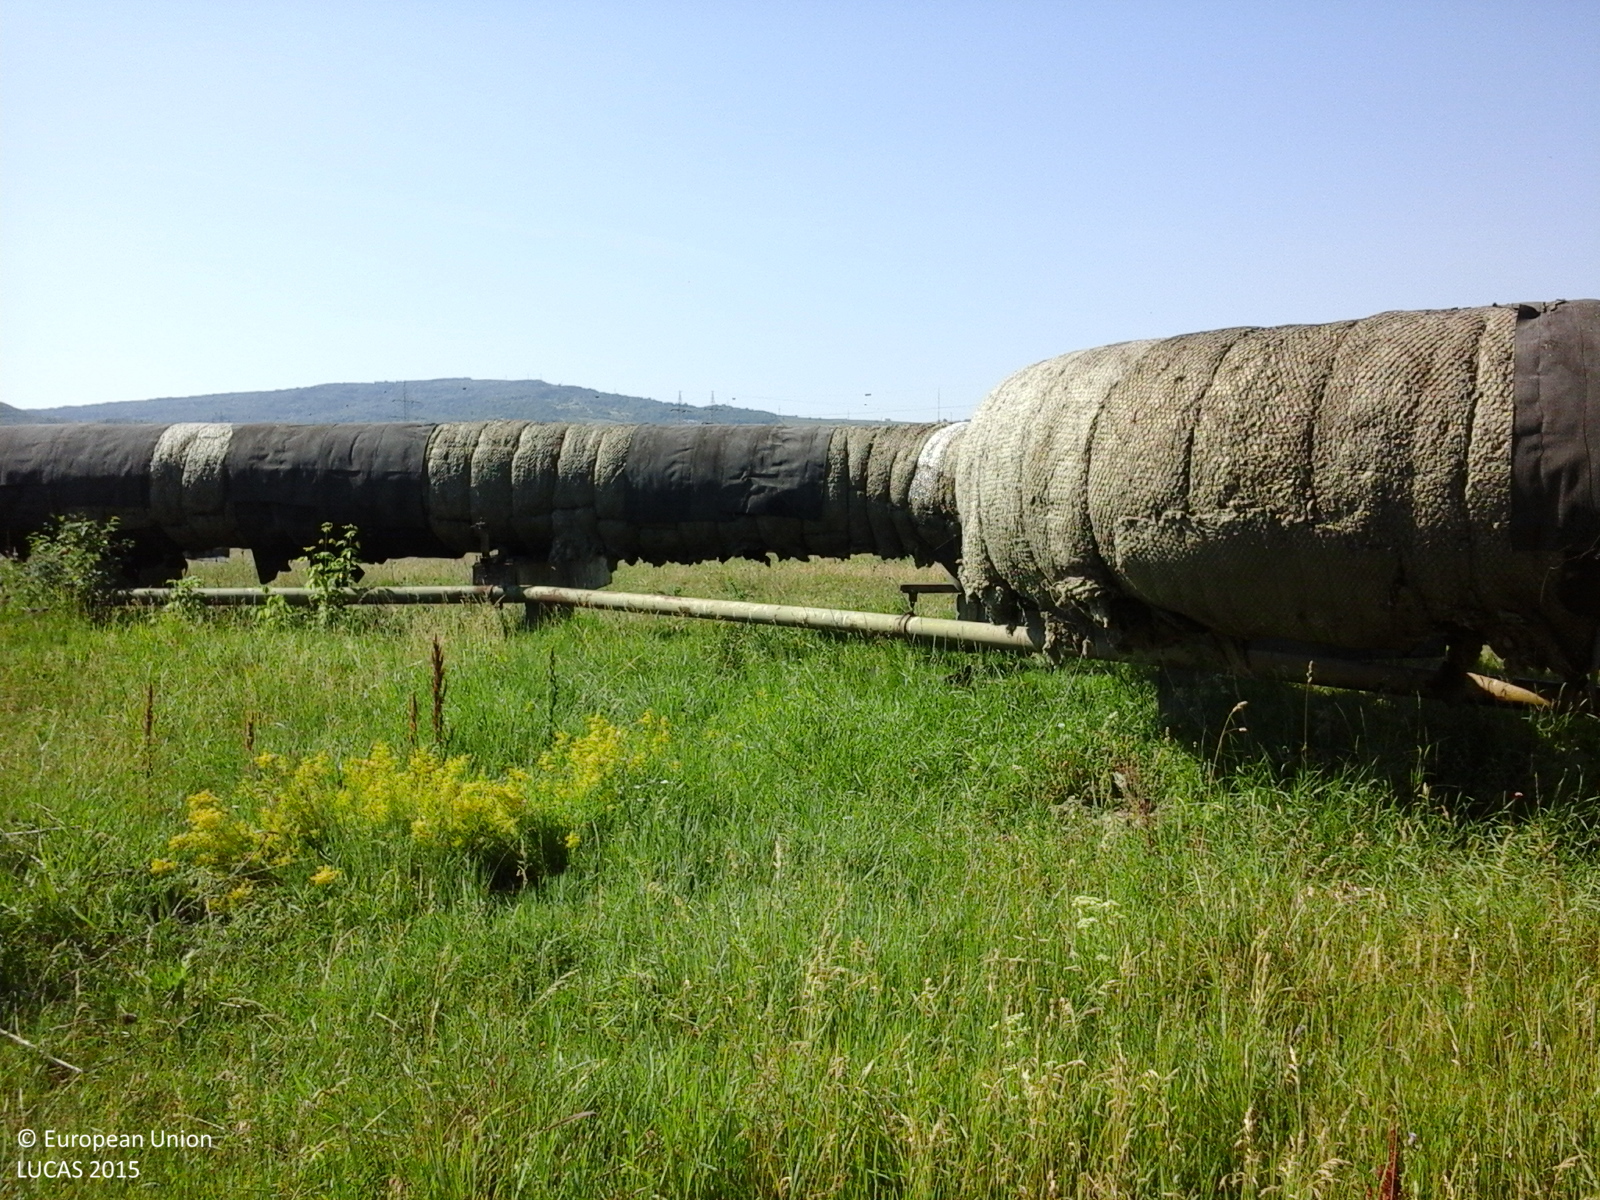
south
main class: Grassland
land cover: Grassland with sparse tree/shrub cover
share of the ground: > 75 %
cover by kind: herbaceous plants 90 %, broadleaved forest trees 5 %, shrubs 5 %
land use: Semi-natural and natural areas not in use
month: June
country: RO
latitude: 47.1527
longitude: 27.6481
